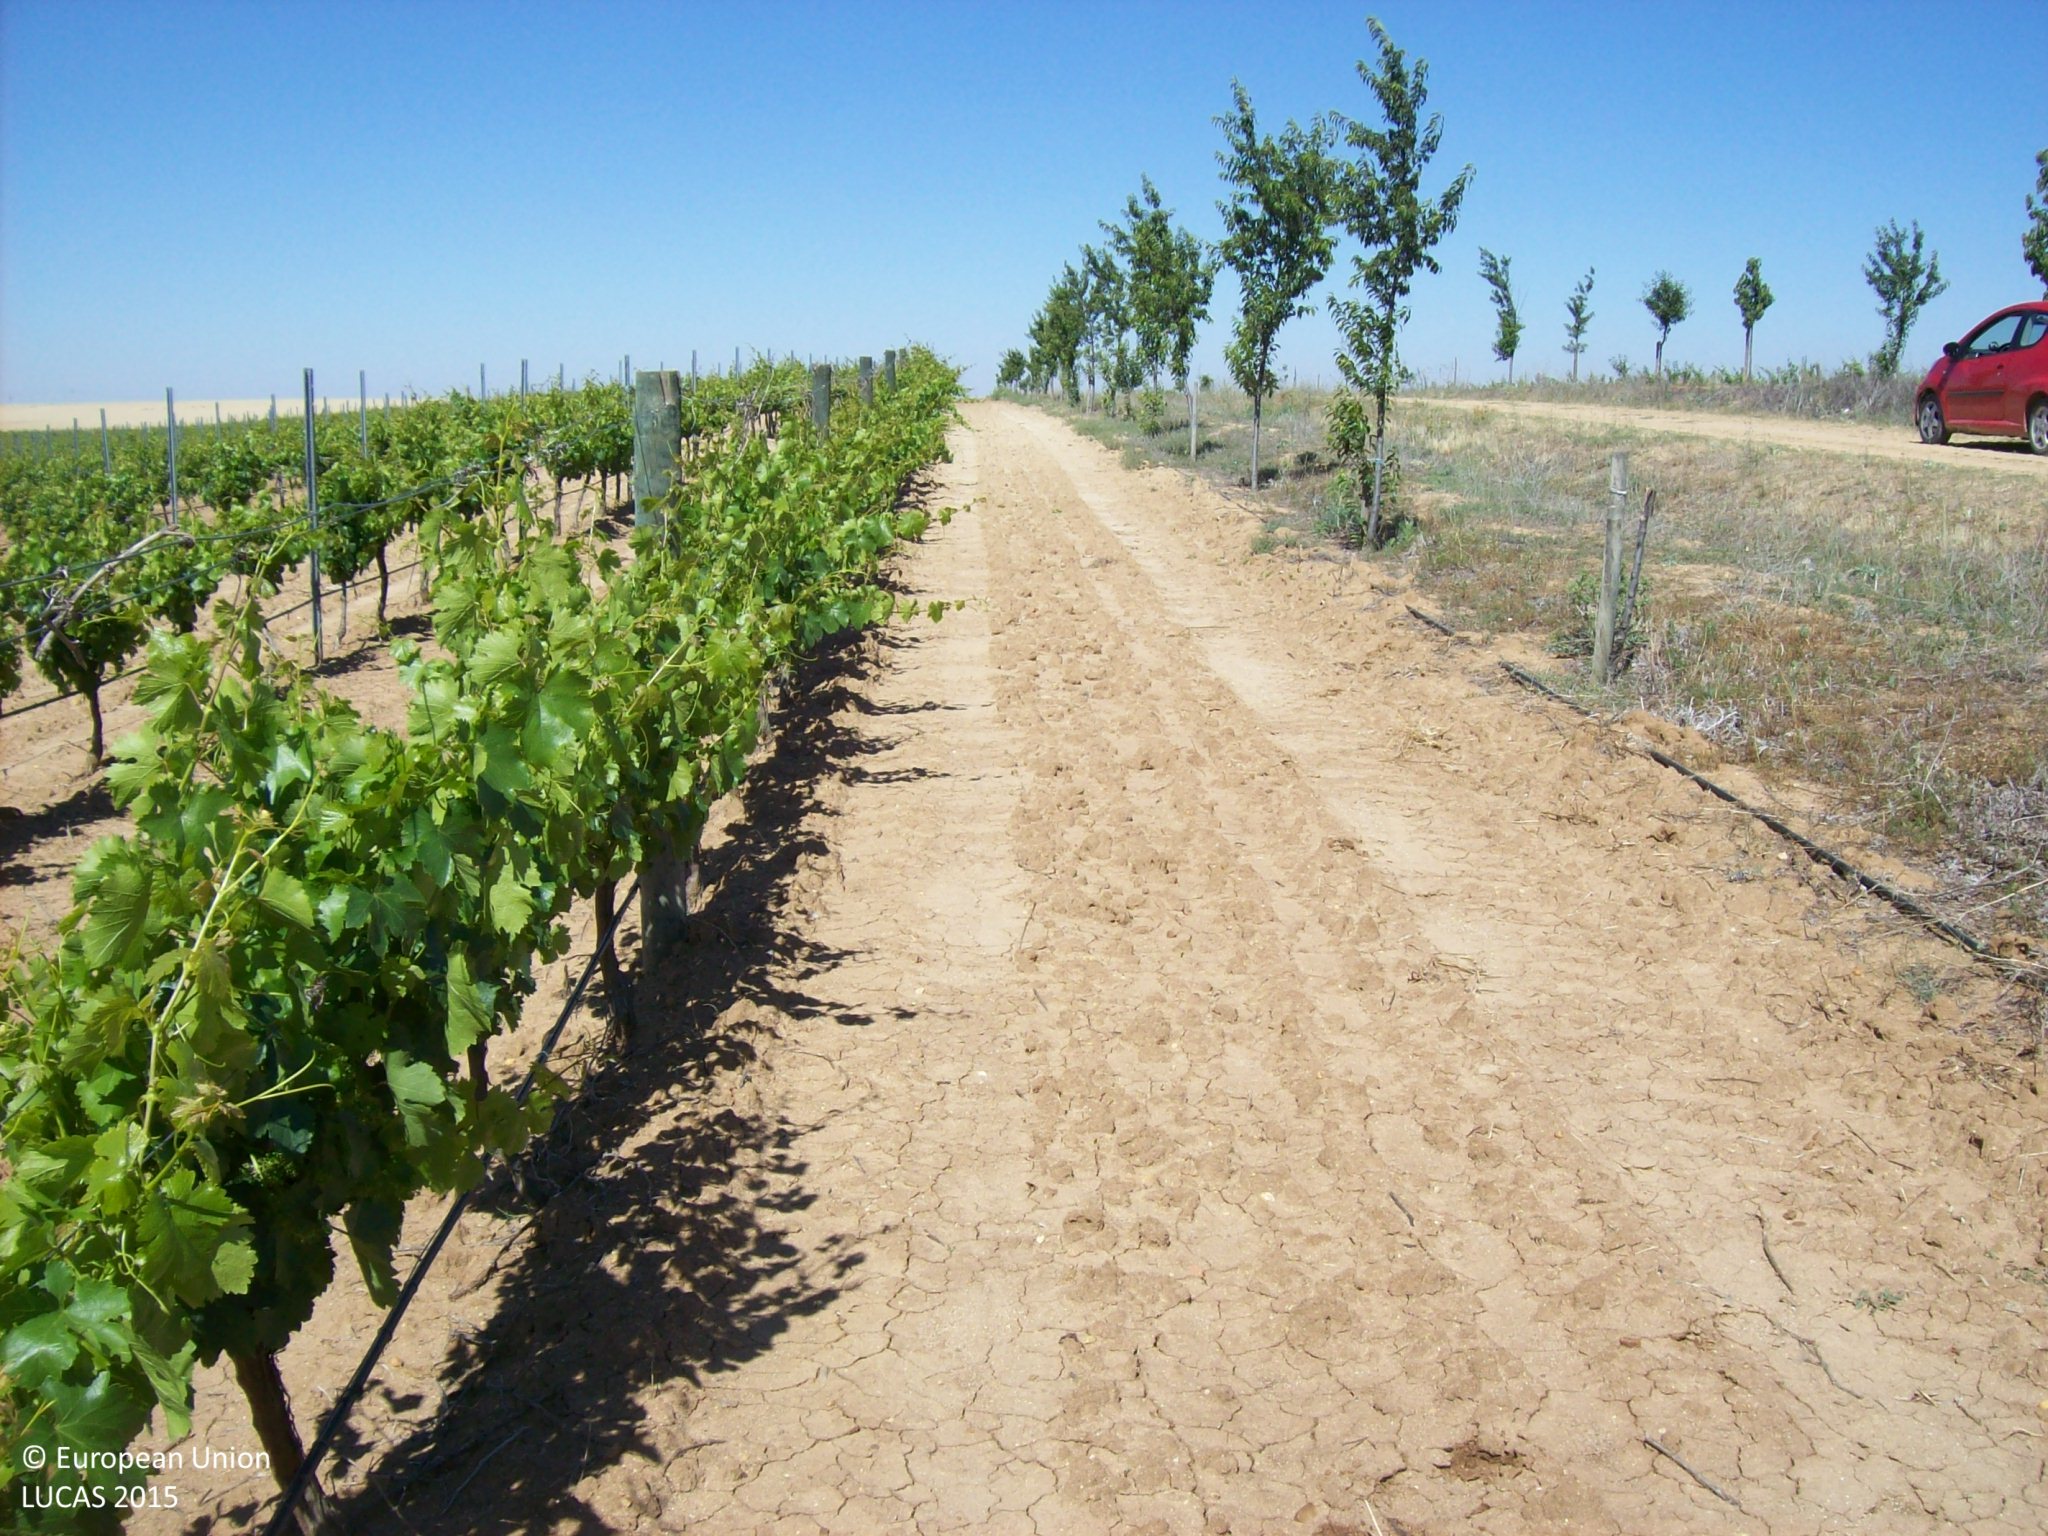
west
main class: Cropland
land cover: Vineyards
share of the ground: 25 - 50 %
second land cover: Other bare soil
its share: > 75 %
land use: Agriculture (excluding fallow land and kitchen gardens)
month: June
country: ES
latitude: 41.2688
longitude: -5.0267
